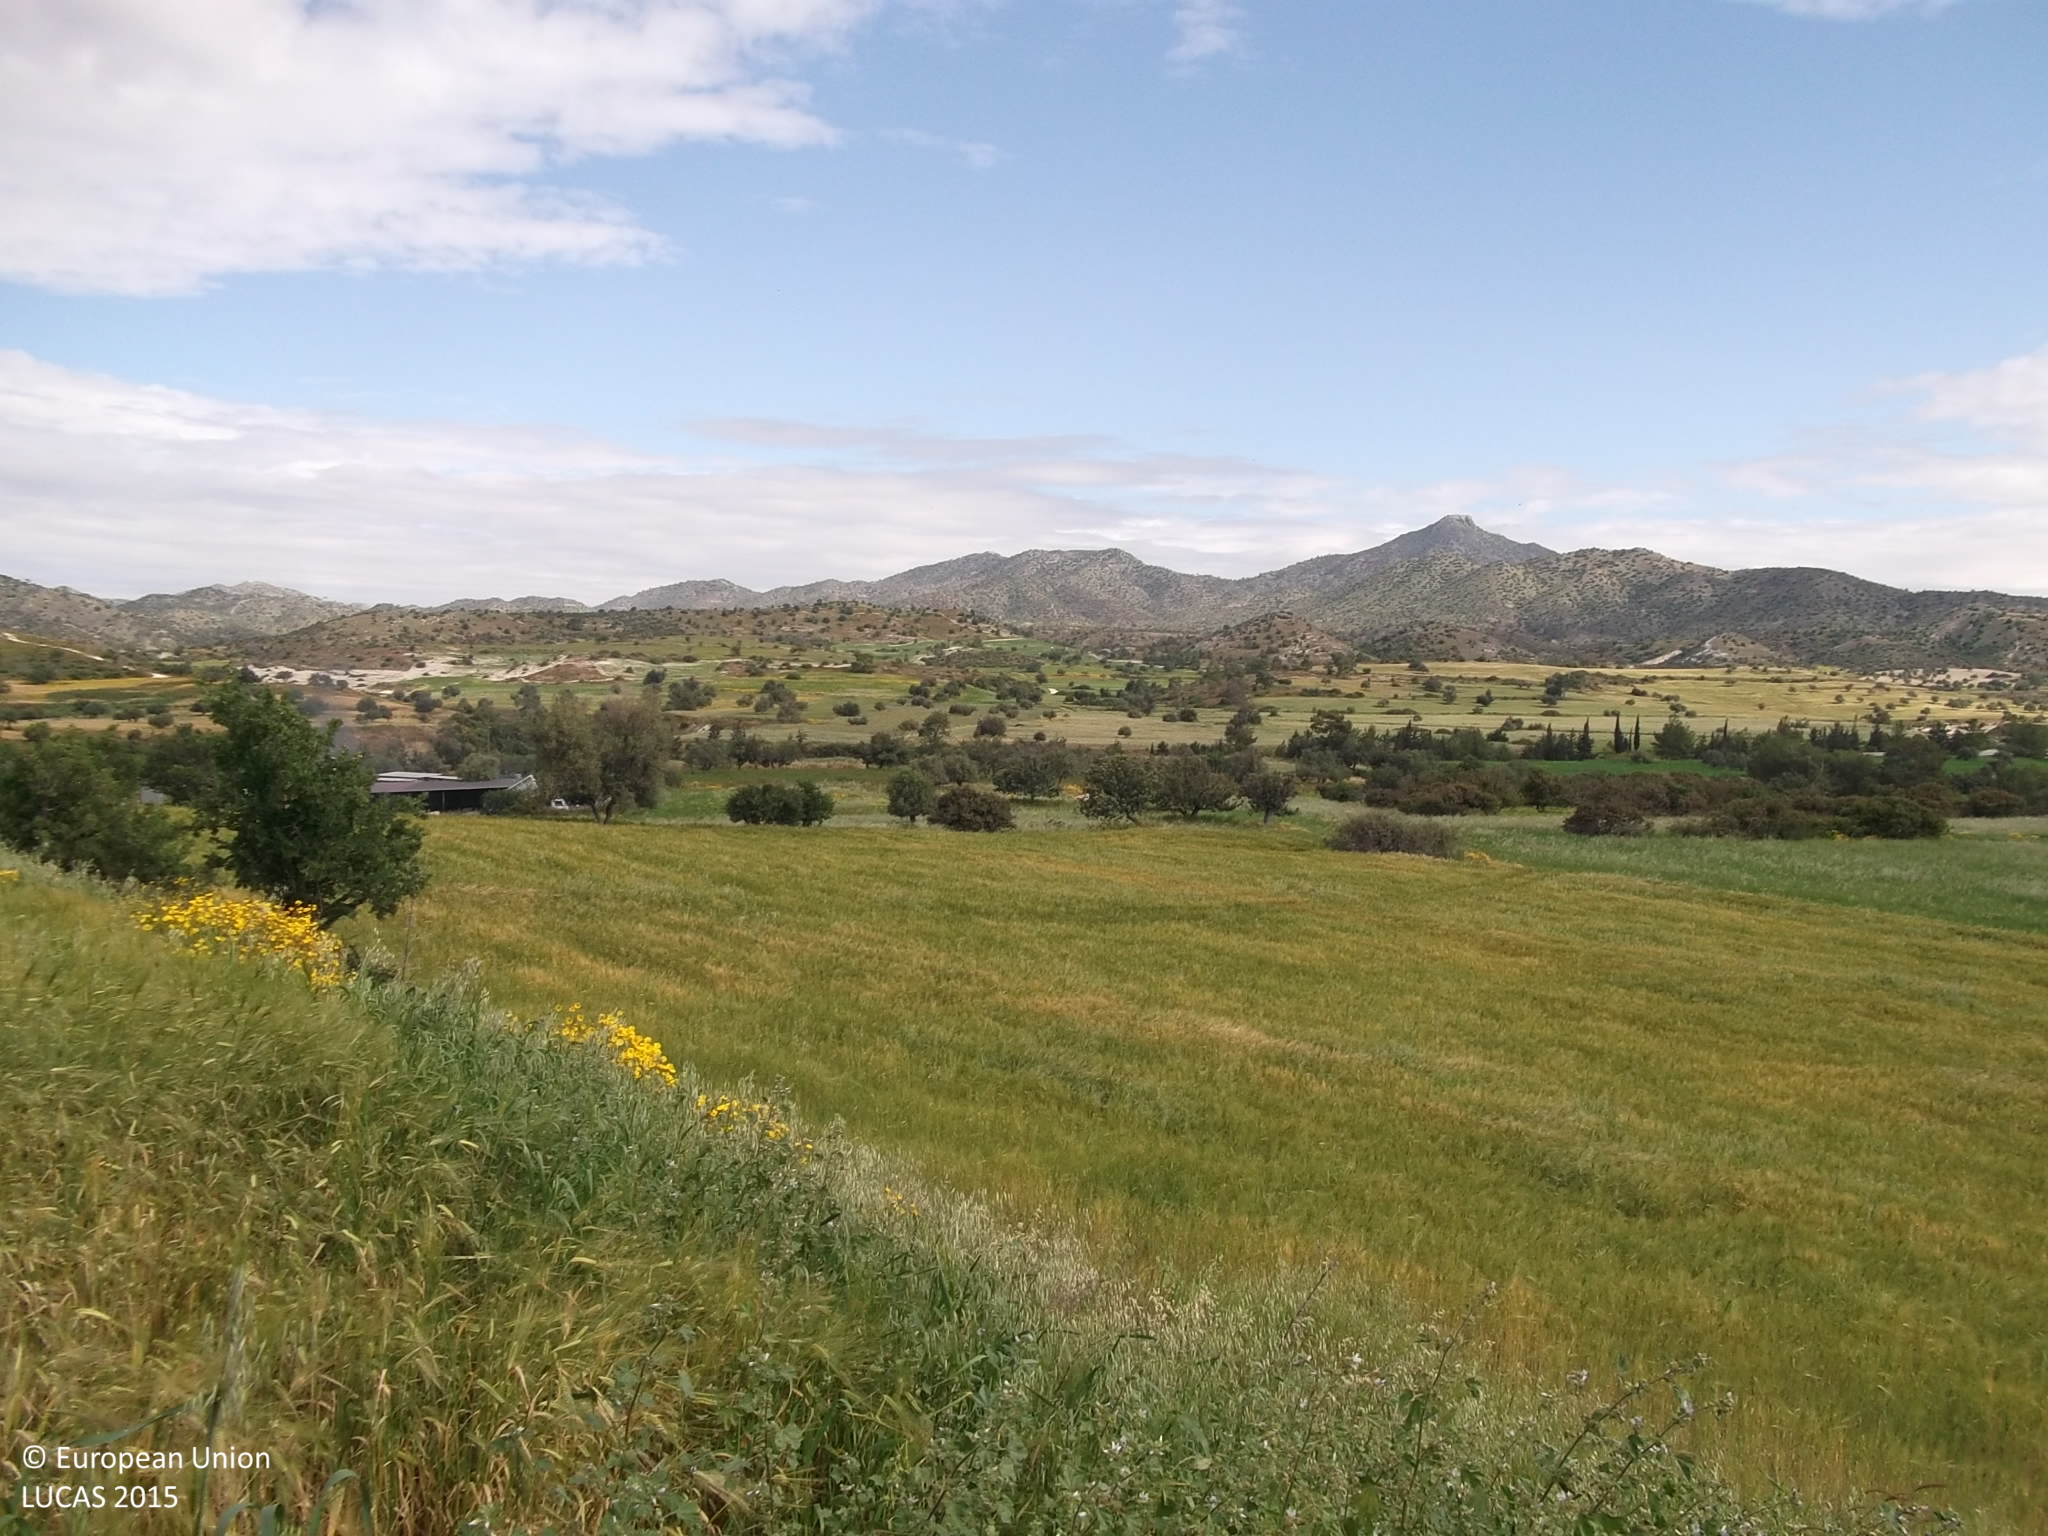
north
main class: Shrubland
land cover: Shrubland without tree cover
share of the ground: > 75 %
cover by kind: shrubs 80 %, herbaceous plants 20 %
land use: Semi-natural and natural areas not in use
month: April
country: CY
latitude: 34.8352
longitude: 33.4217
